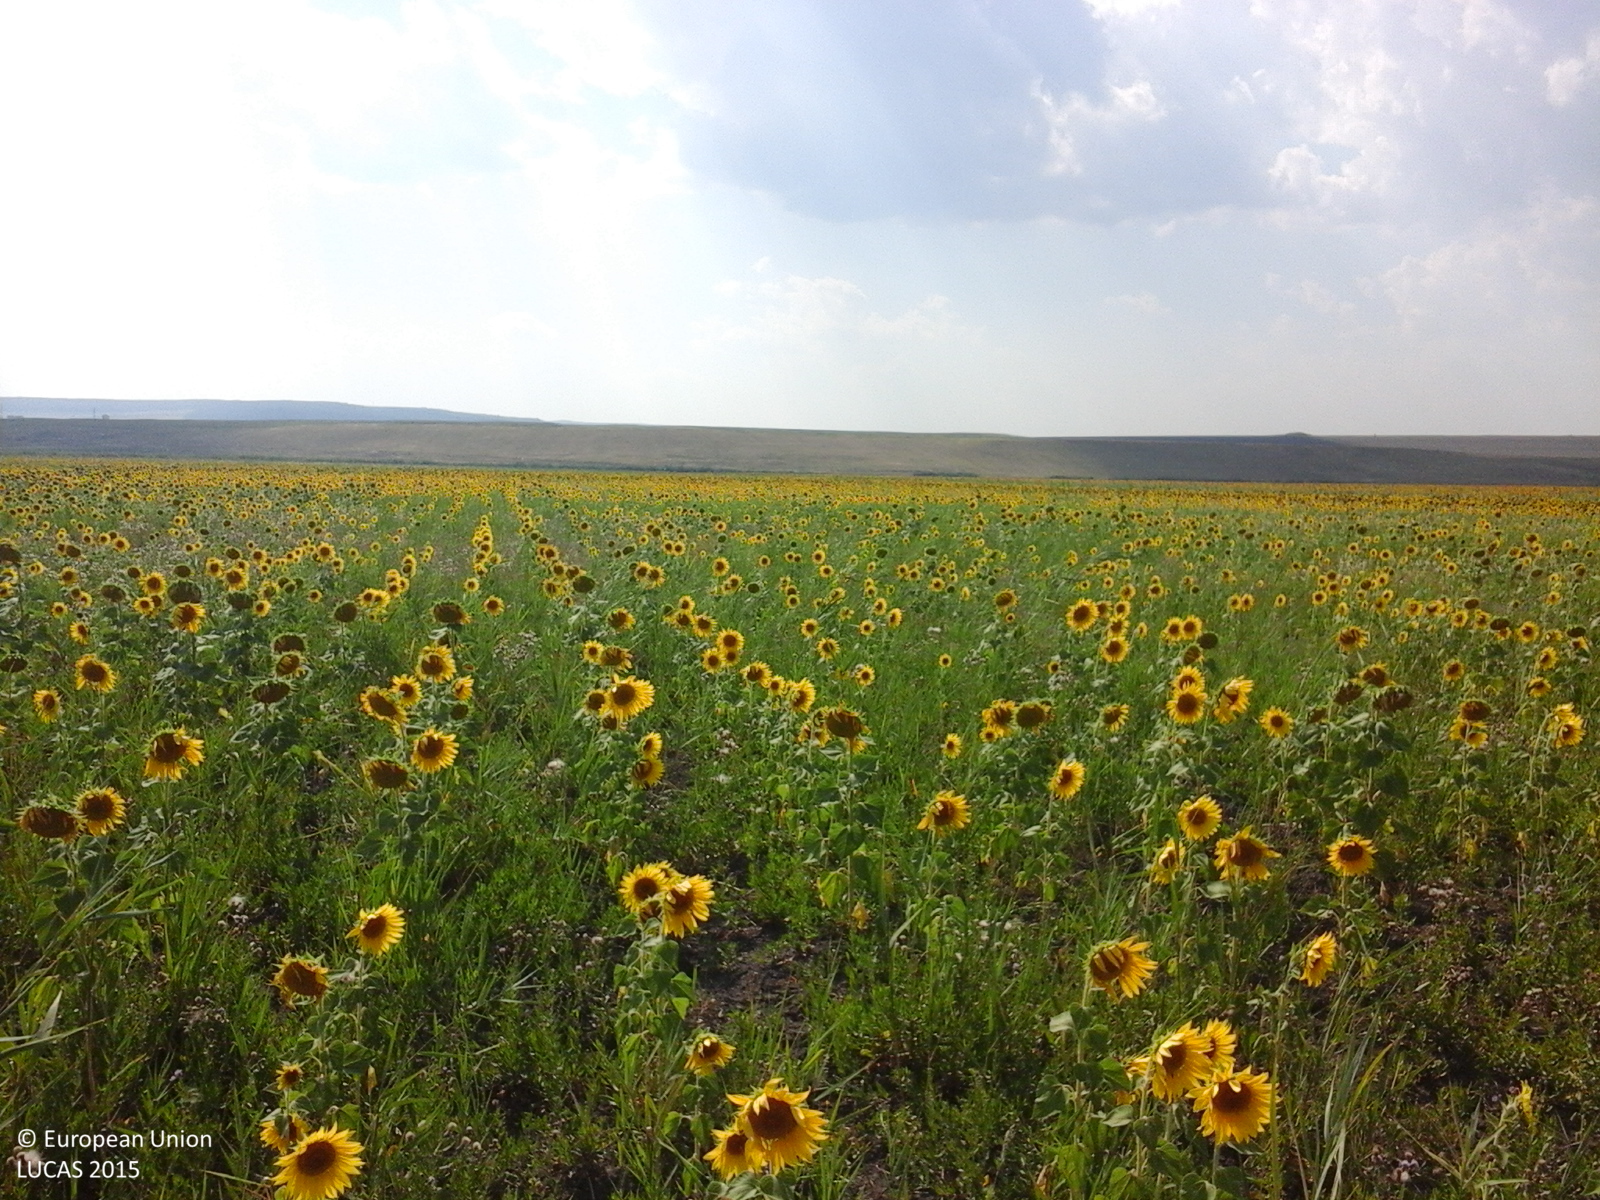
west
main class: Cropland
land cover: Sunflower
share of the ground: > 75 %
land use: Agriculture (excluding fallow land and kitchen gardens)
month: July
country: RO
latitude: 46.6575
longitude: 28.1805
